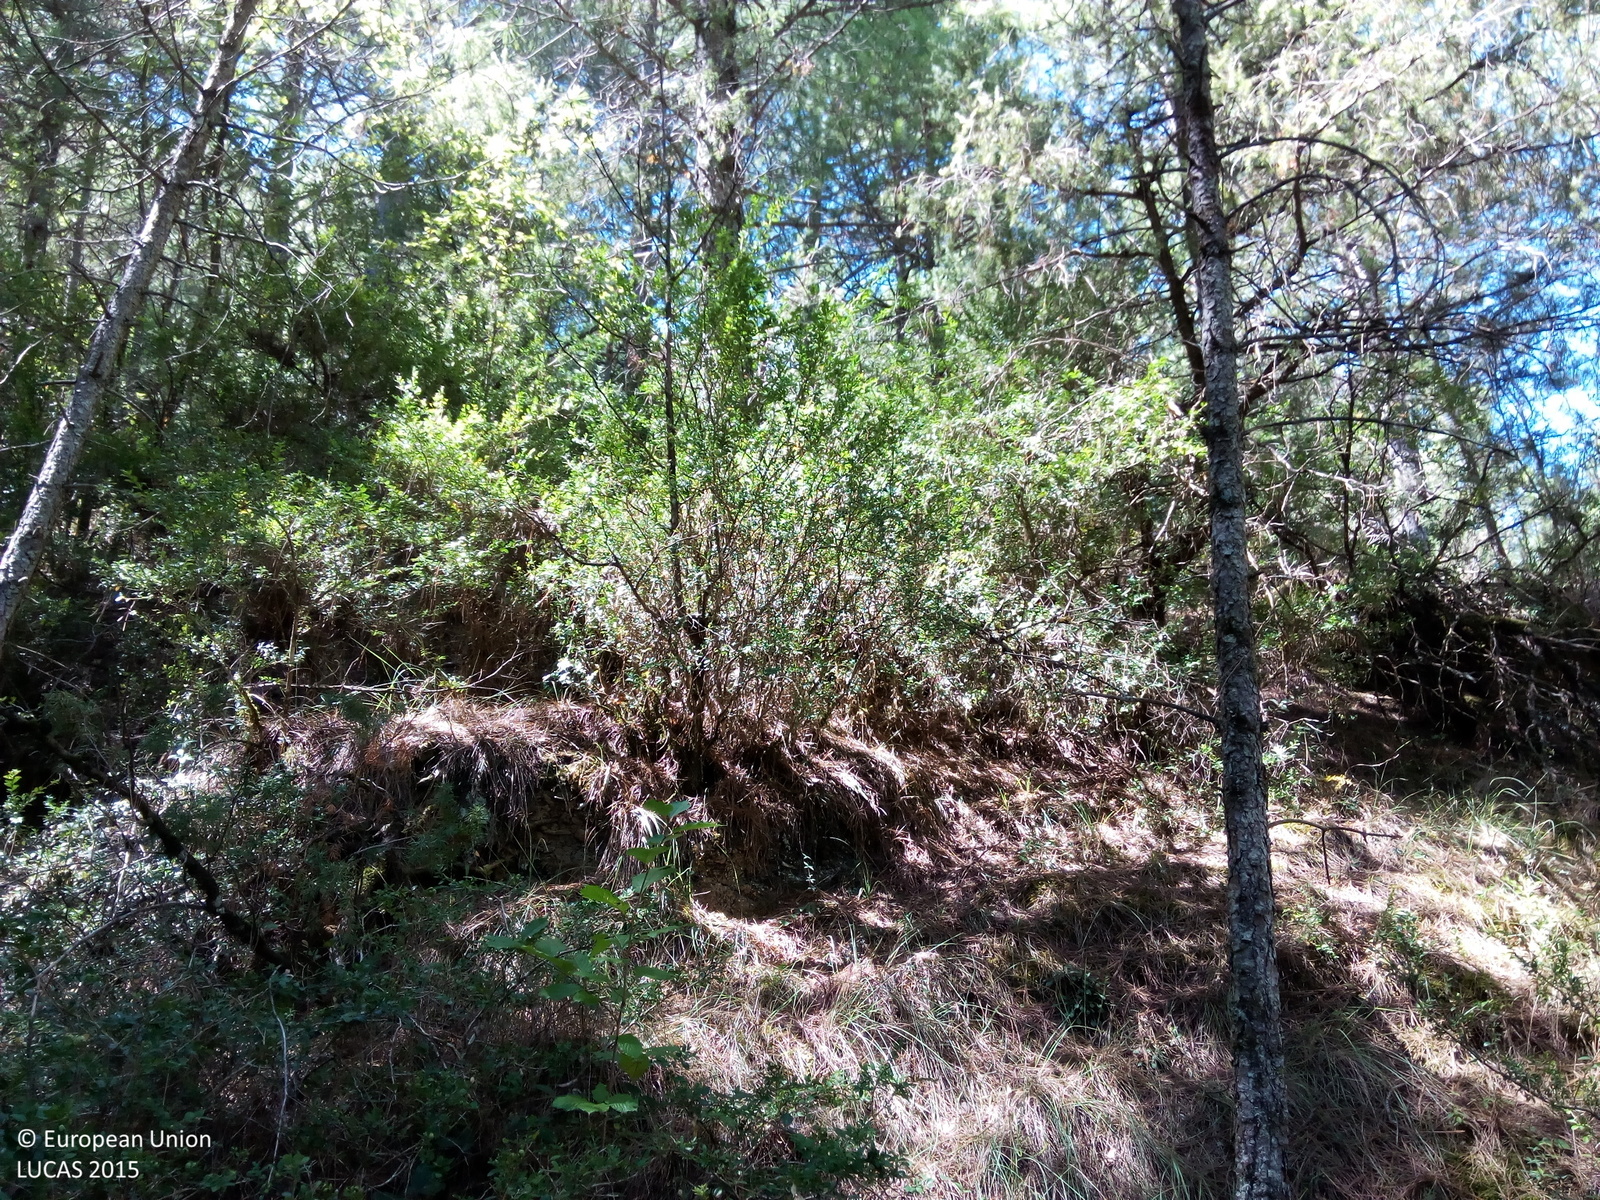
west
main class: Woodland
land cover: Pine dominated coniferous woodland
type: coniferous forest of the mediterranean region
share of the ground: > 75 %
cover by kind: coniferous forest trees 100 %
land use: Forestry
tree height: > 5 m
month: August
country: ES
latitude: 42.4651
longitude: 0.1641
